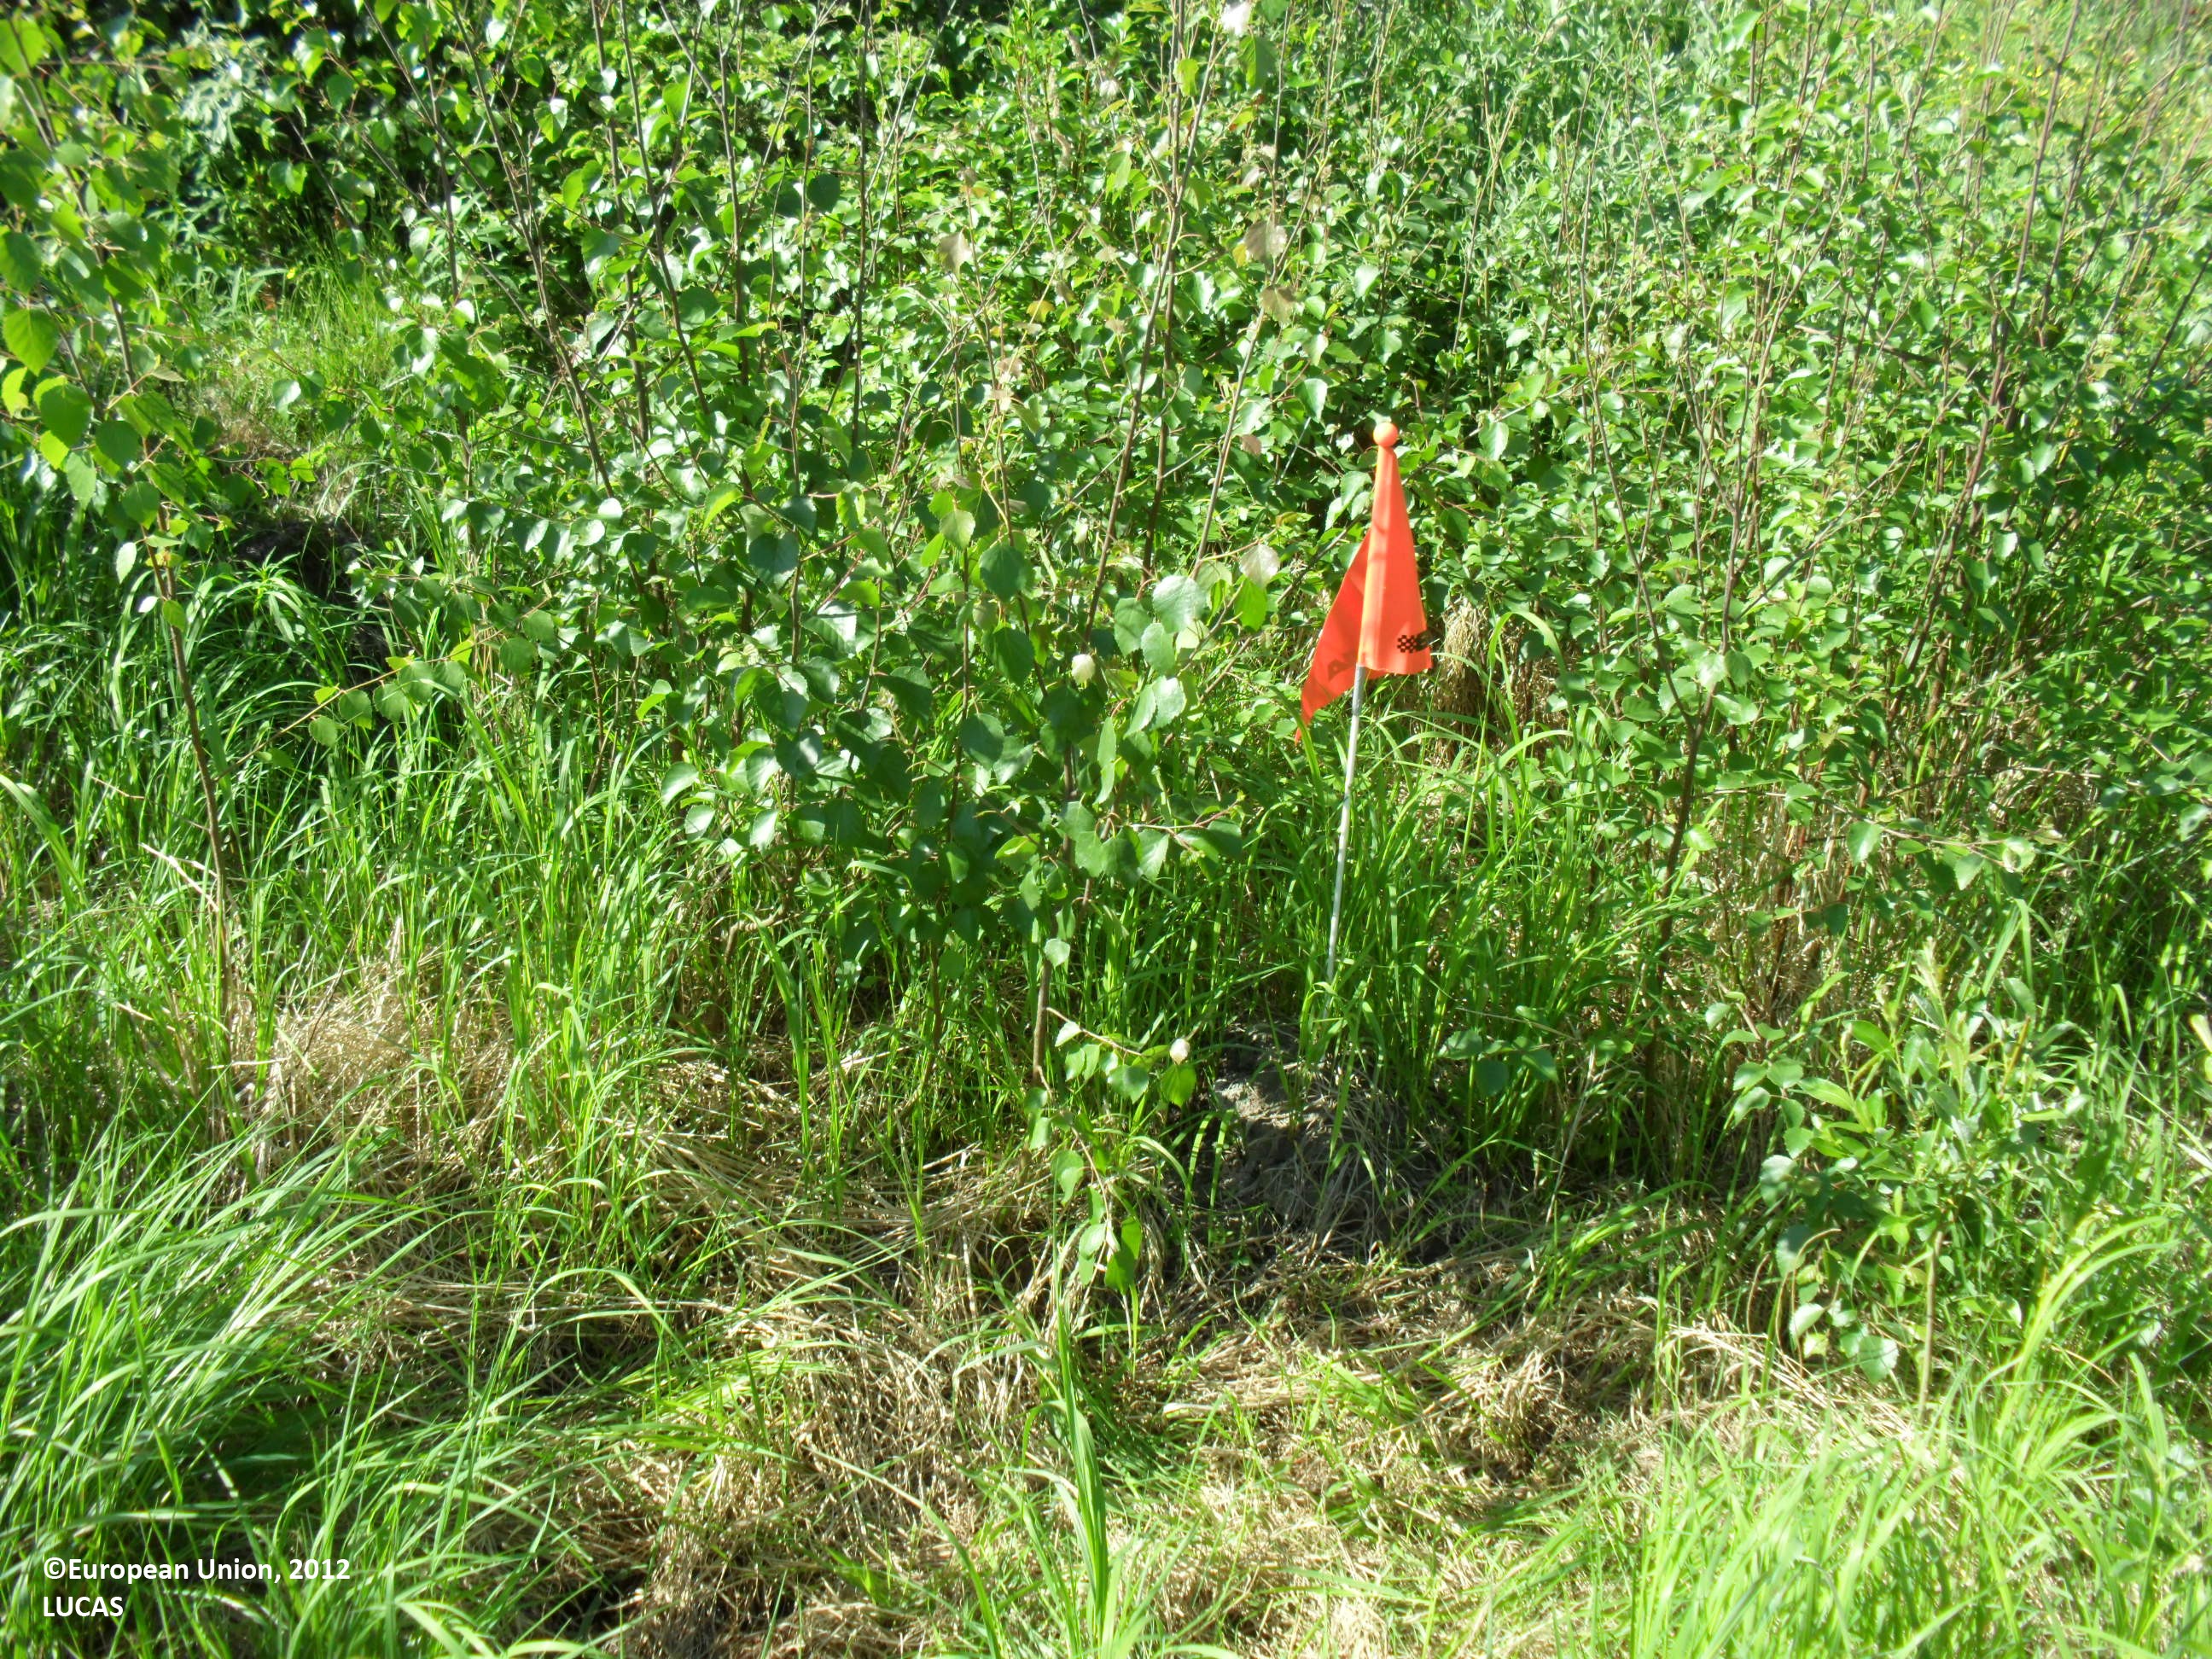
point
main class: Woodland
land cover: Other mixed woodland
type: boreal forest
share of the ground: 10 - 25 %
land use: Forestry
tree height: < 5 m
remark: Clear cut
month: June
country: FI
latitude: 62.9542
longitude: 23.0907
